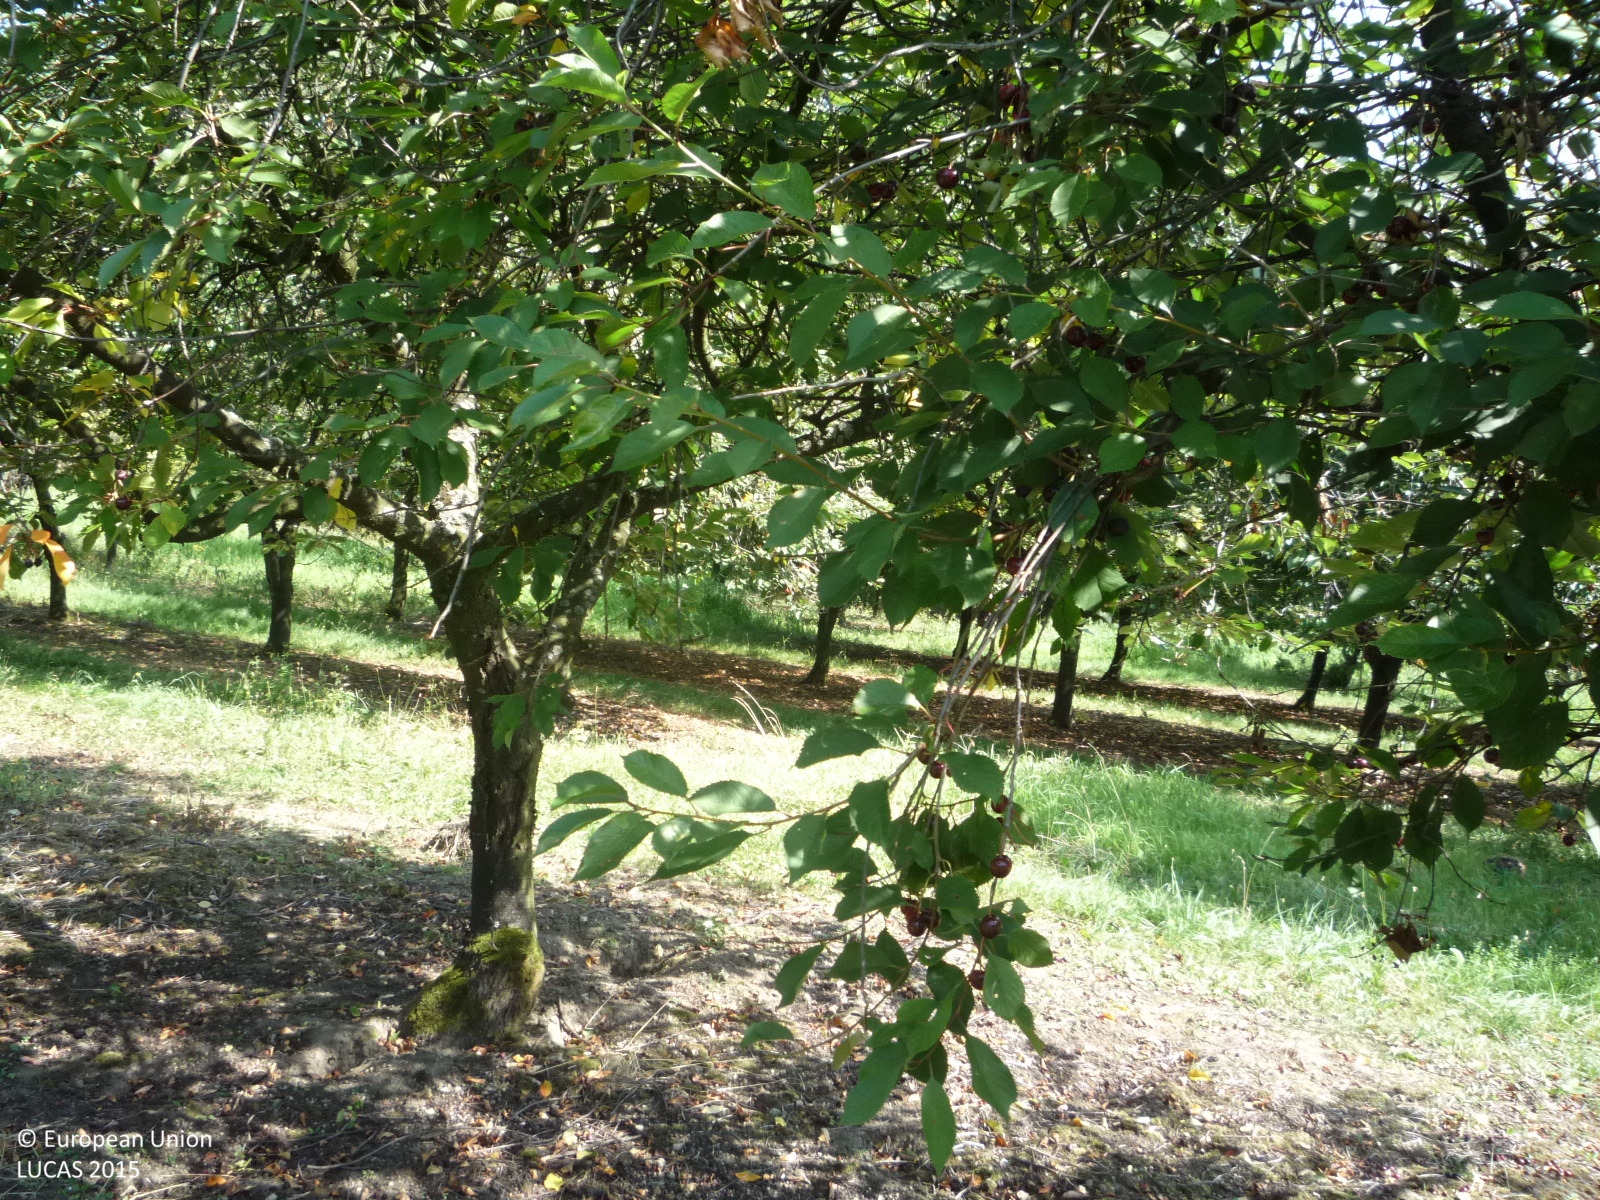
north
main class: Cropland
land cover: Cherry fruit
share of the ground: 50 - 75 %
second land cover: Grassland without tree/shrub cover
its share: > 75 %
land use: Agriculture (excluding fallow land and kitchen gardens)
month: August
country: CZ
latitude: 50.6233
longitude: 15.2193
